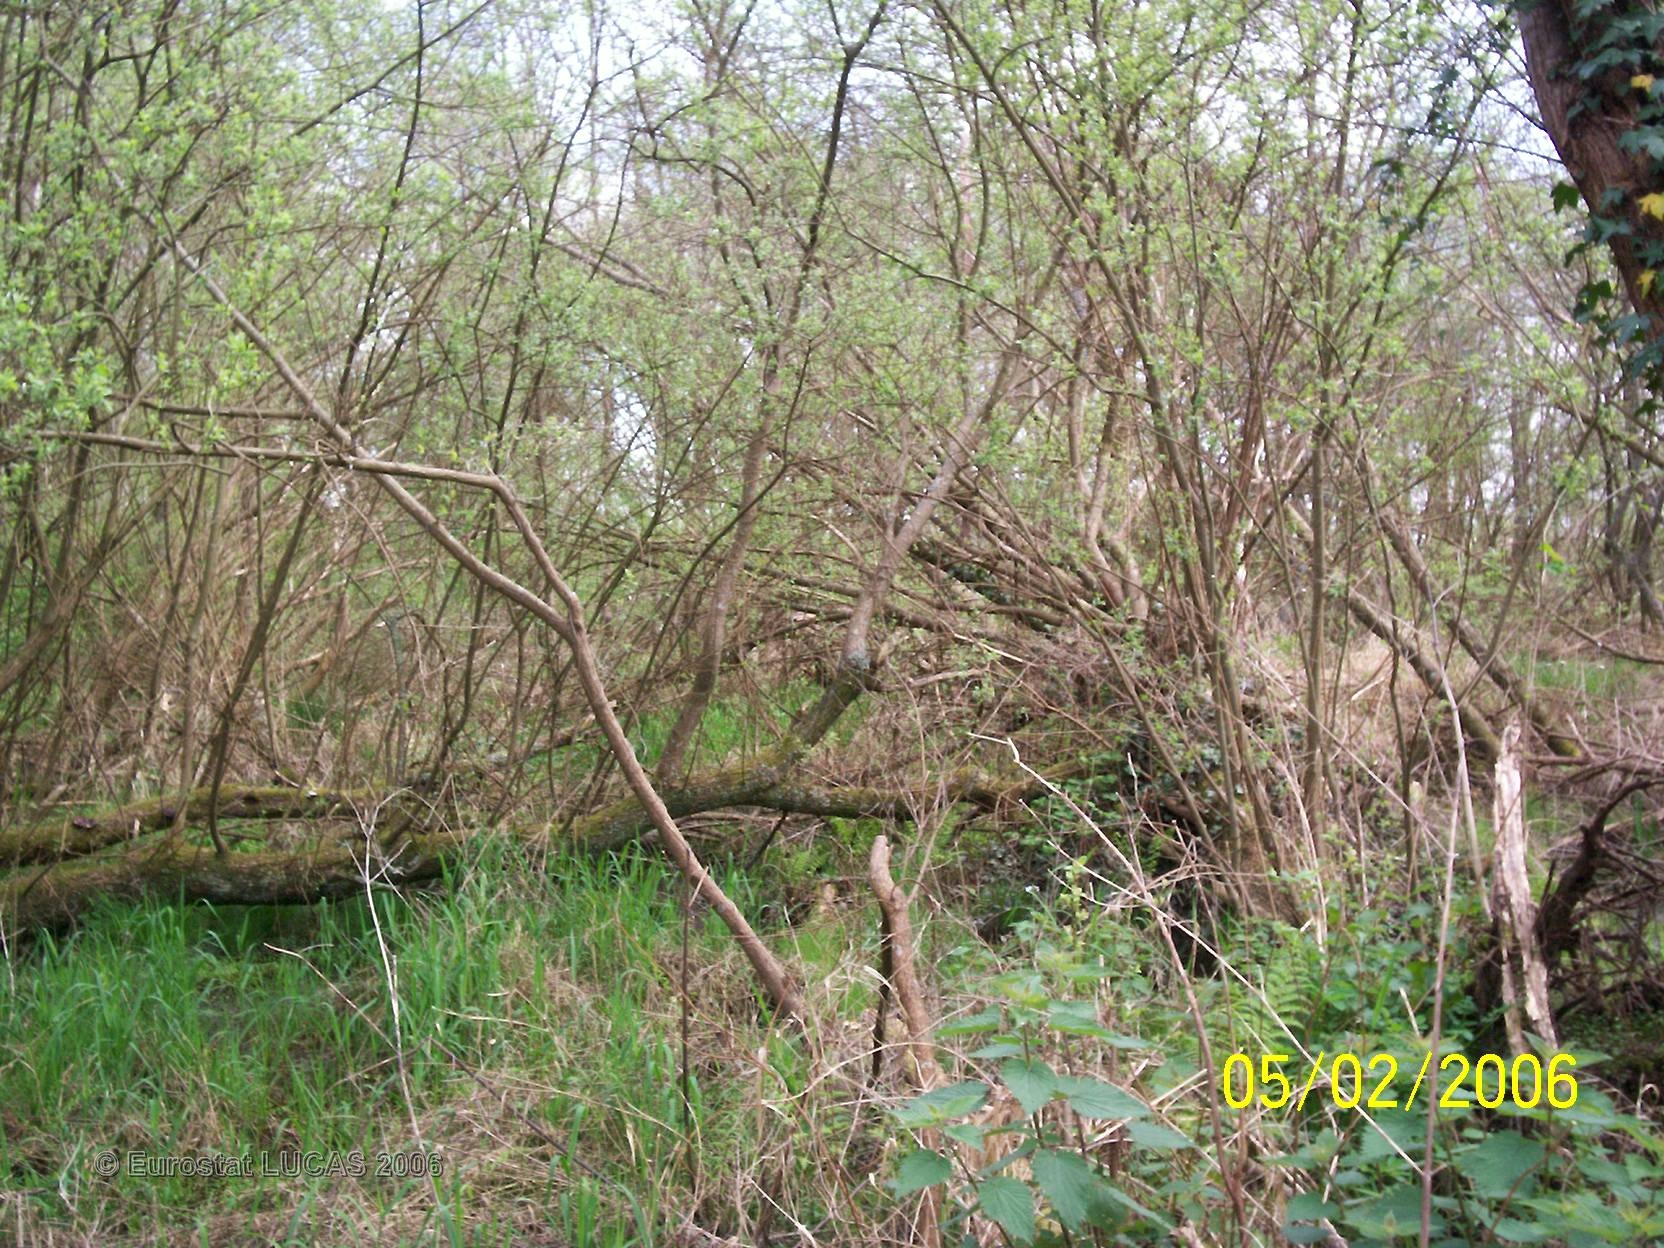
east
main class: Woodland
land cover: Broadleaved forest
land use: Forestry
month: April
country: FR
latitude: 43.6487
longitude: -1.3875
